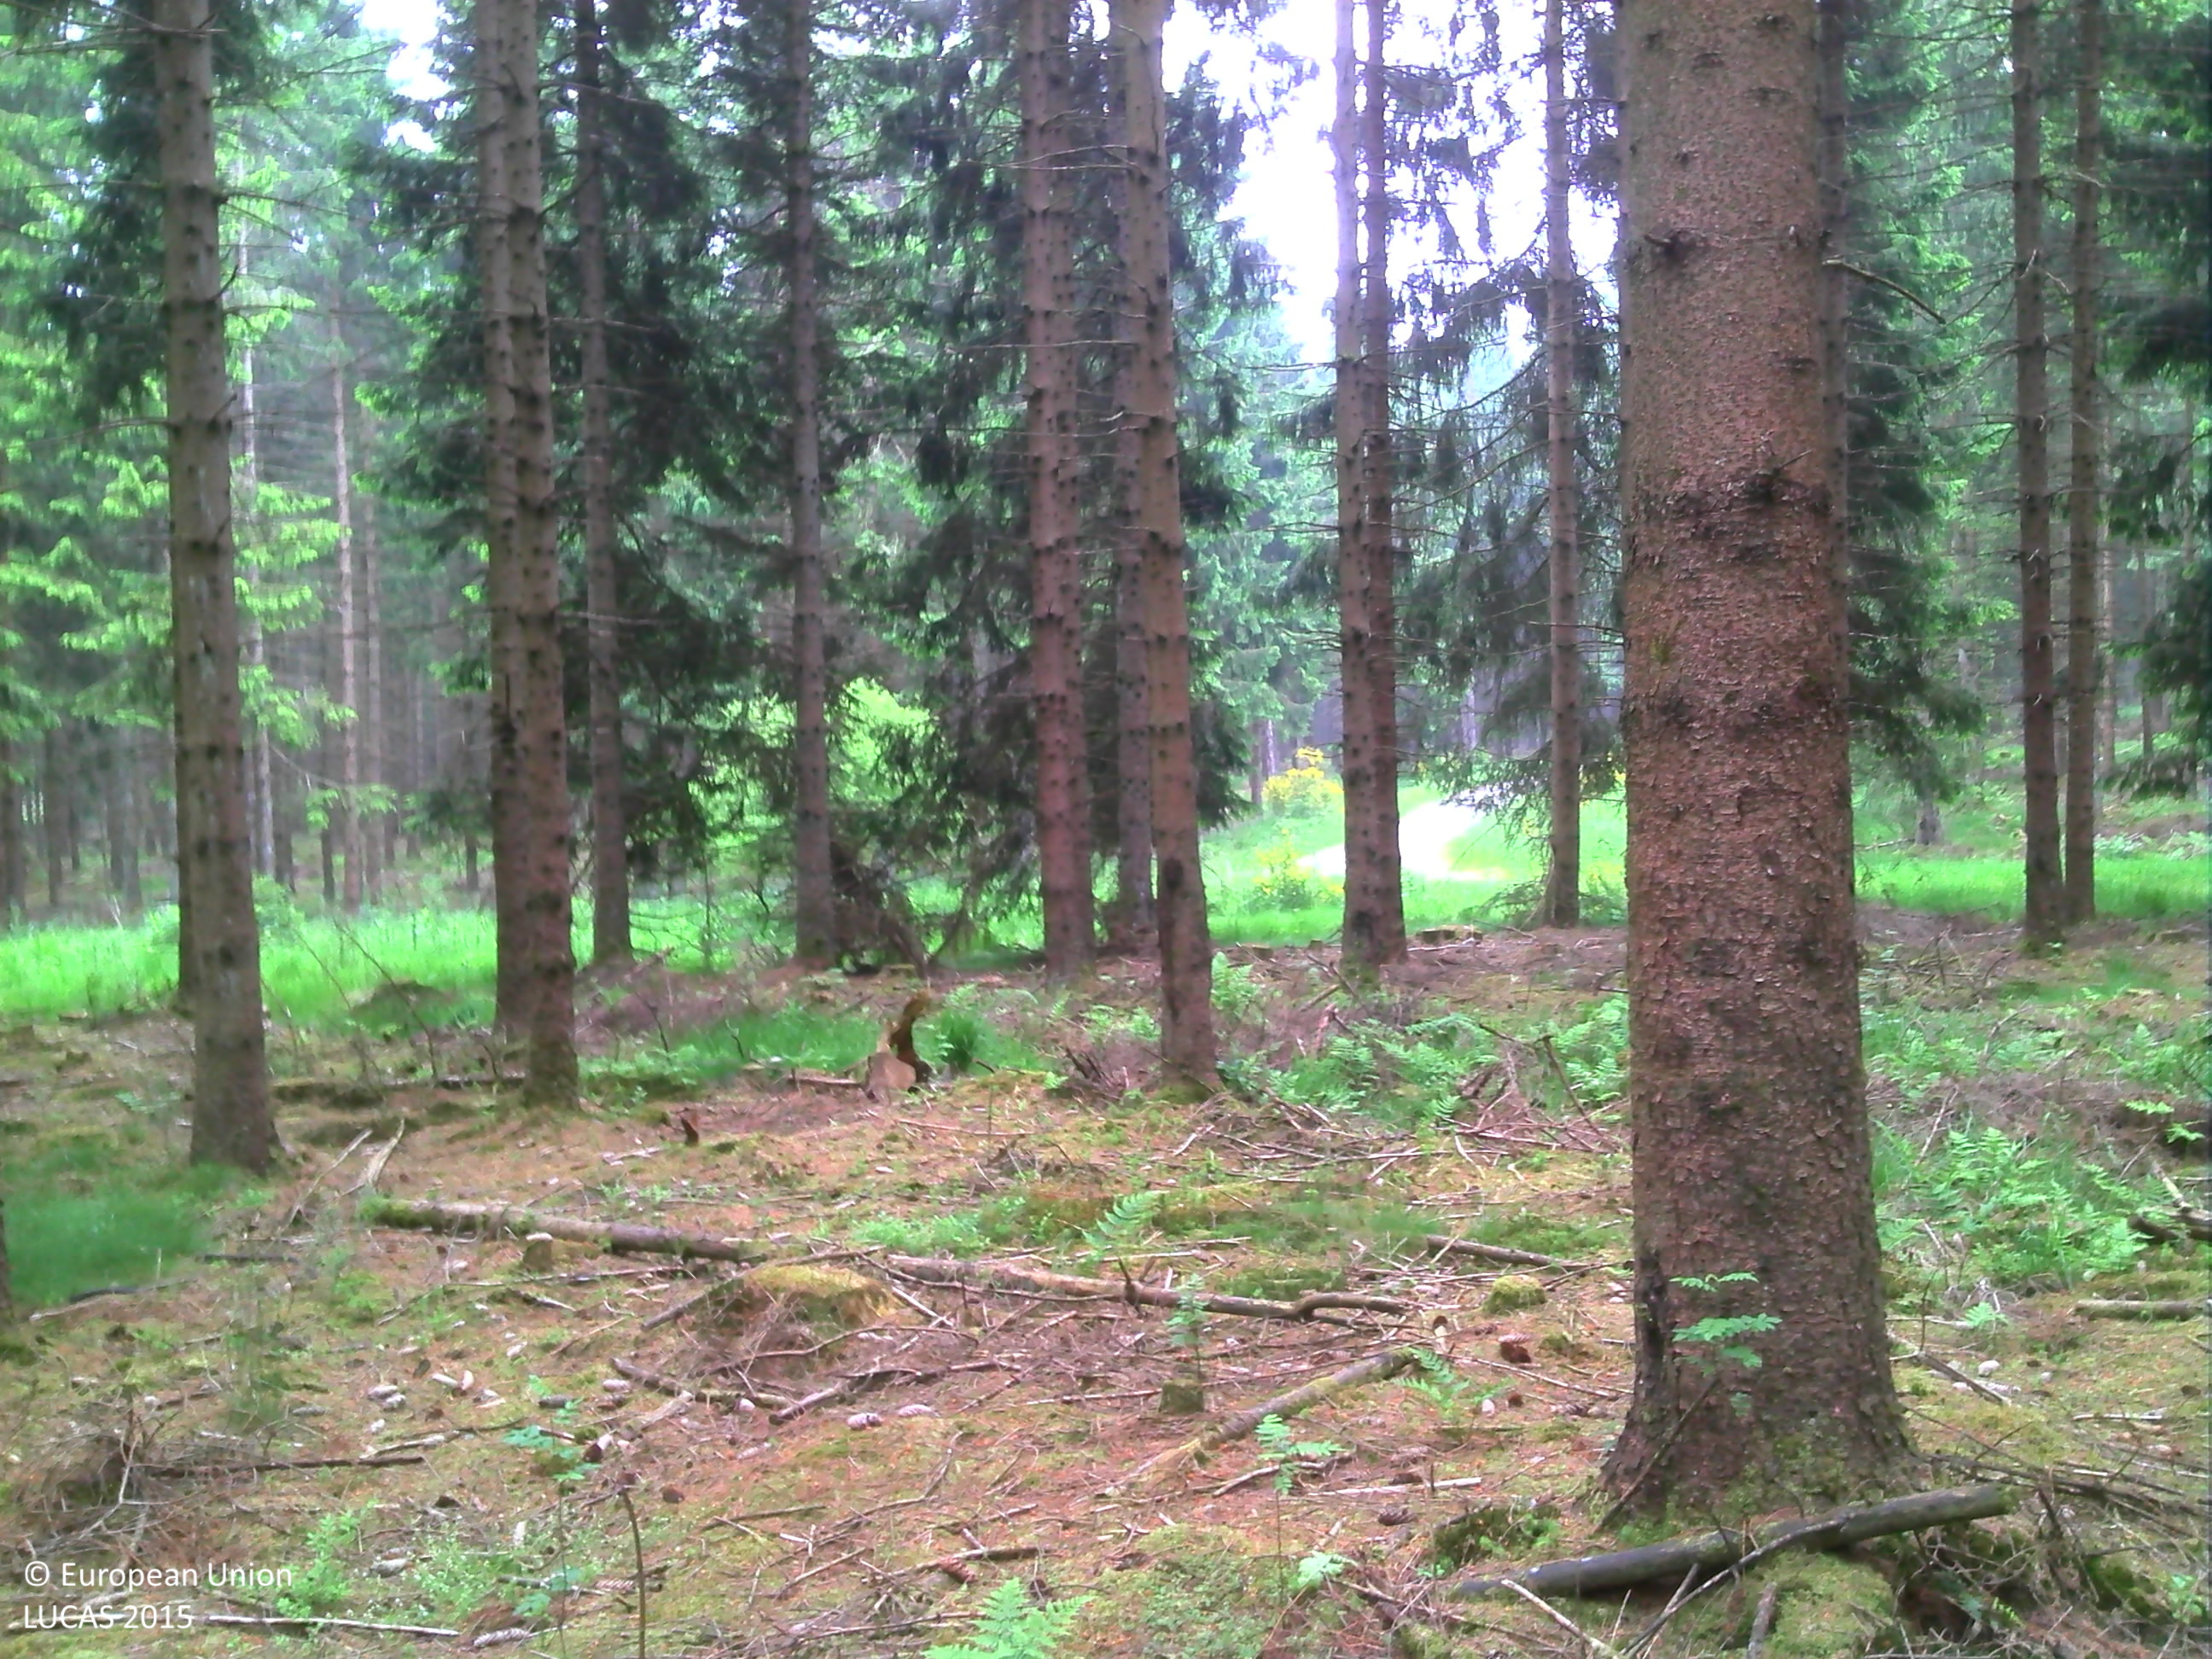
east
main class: Woodland
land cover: Spruce dominated coniferous woodland
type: exotic forest
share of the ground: > 75 %
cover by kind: coniferous forest trees 95 %, herbaceous plants 5 %
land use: Forestry
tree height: > 5 m
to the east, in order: Spruce dominated coniferous woodland; Spontaneously vegetated surfaces; Ditches and canals; Grass margins; Paved roads, cycling and walking lanes; Grass margins; Spruce dominated coniferous woodland; Spontaneously vegetated surfaces; Ditches and canals; Spruce dominated coniferous woodland
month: June
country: BE
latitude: 50.4661
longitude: 6.2942
